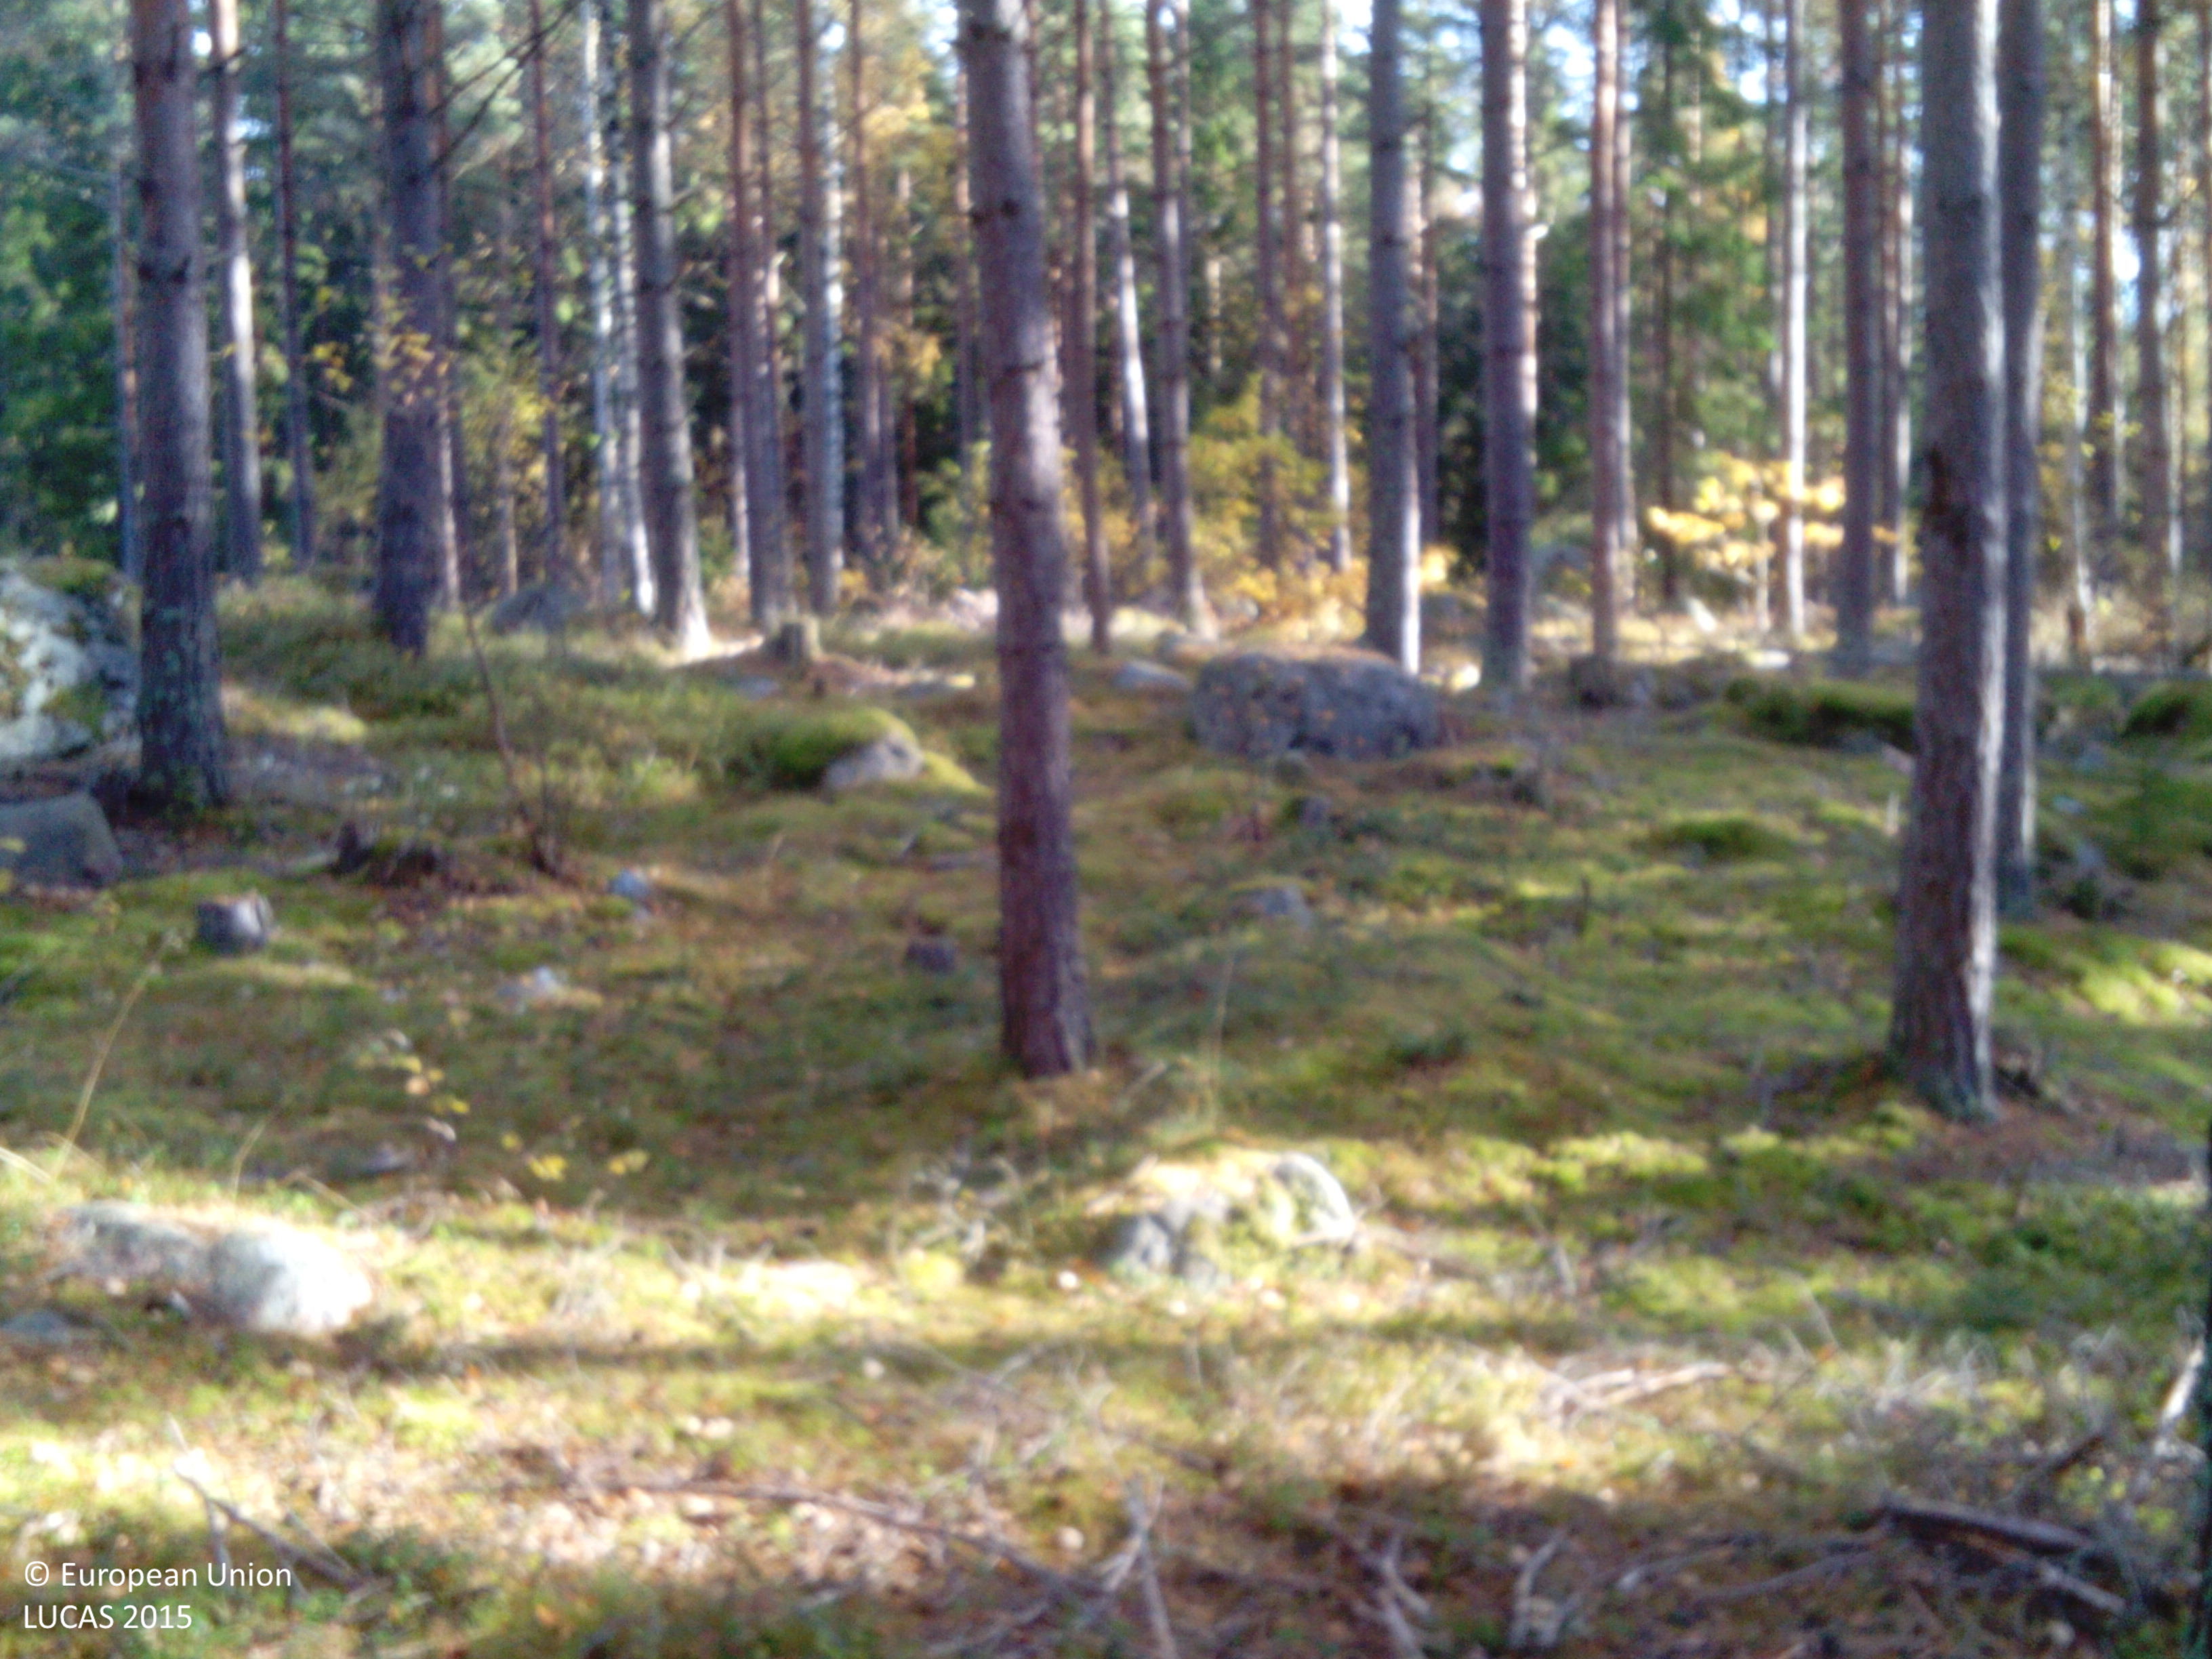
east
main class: Woodland
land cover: Pine dominated coniferous woodland
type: boreal forest
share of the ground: > 75 %
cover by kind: coniferous forest trees 75 %, broadleaved forest trees 10 %, lichens and mosses 10 %, herbaceous plants 5 %
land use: Forestry
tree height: > 5 m
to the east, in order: Pine dominated coniferous woodland; Tracks; Pine dominated coniferous woodland; Ditches and canals; Spruce dominated coniferous woodland; Ditches and canals; Spruce dominated coniferous woodland; Other coniferous woodland
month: October
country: SE
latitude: 59.0261
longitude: 16.3525
